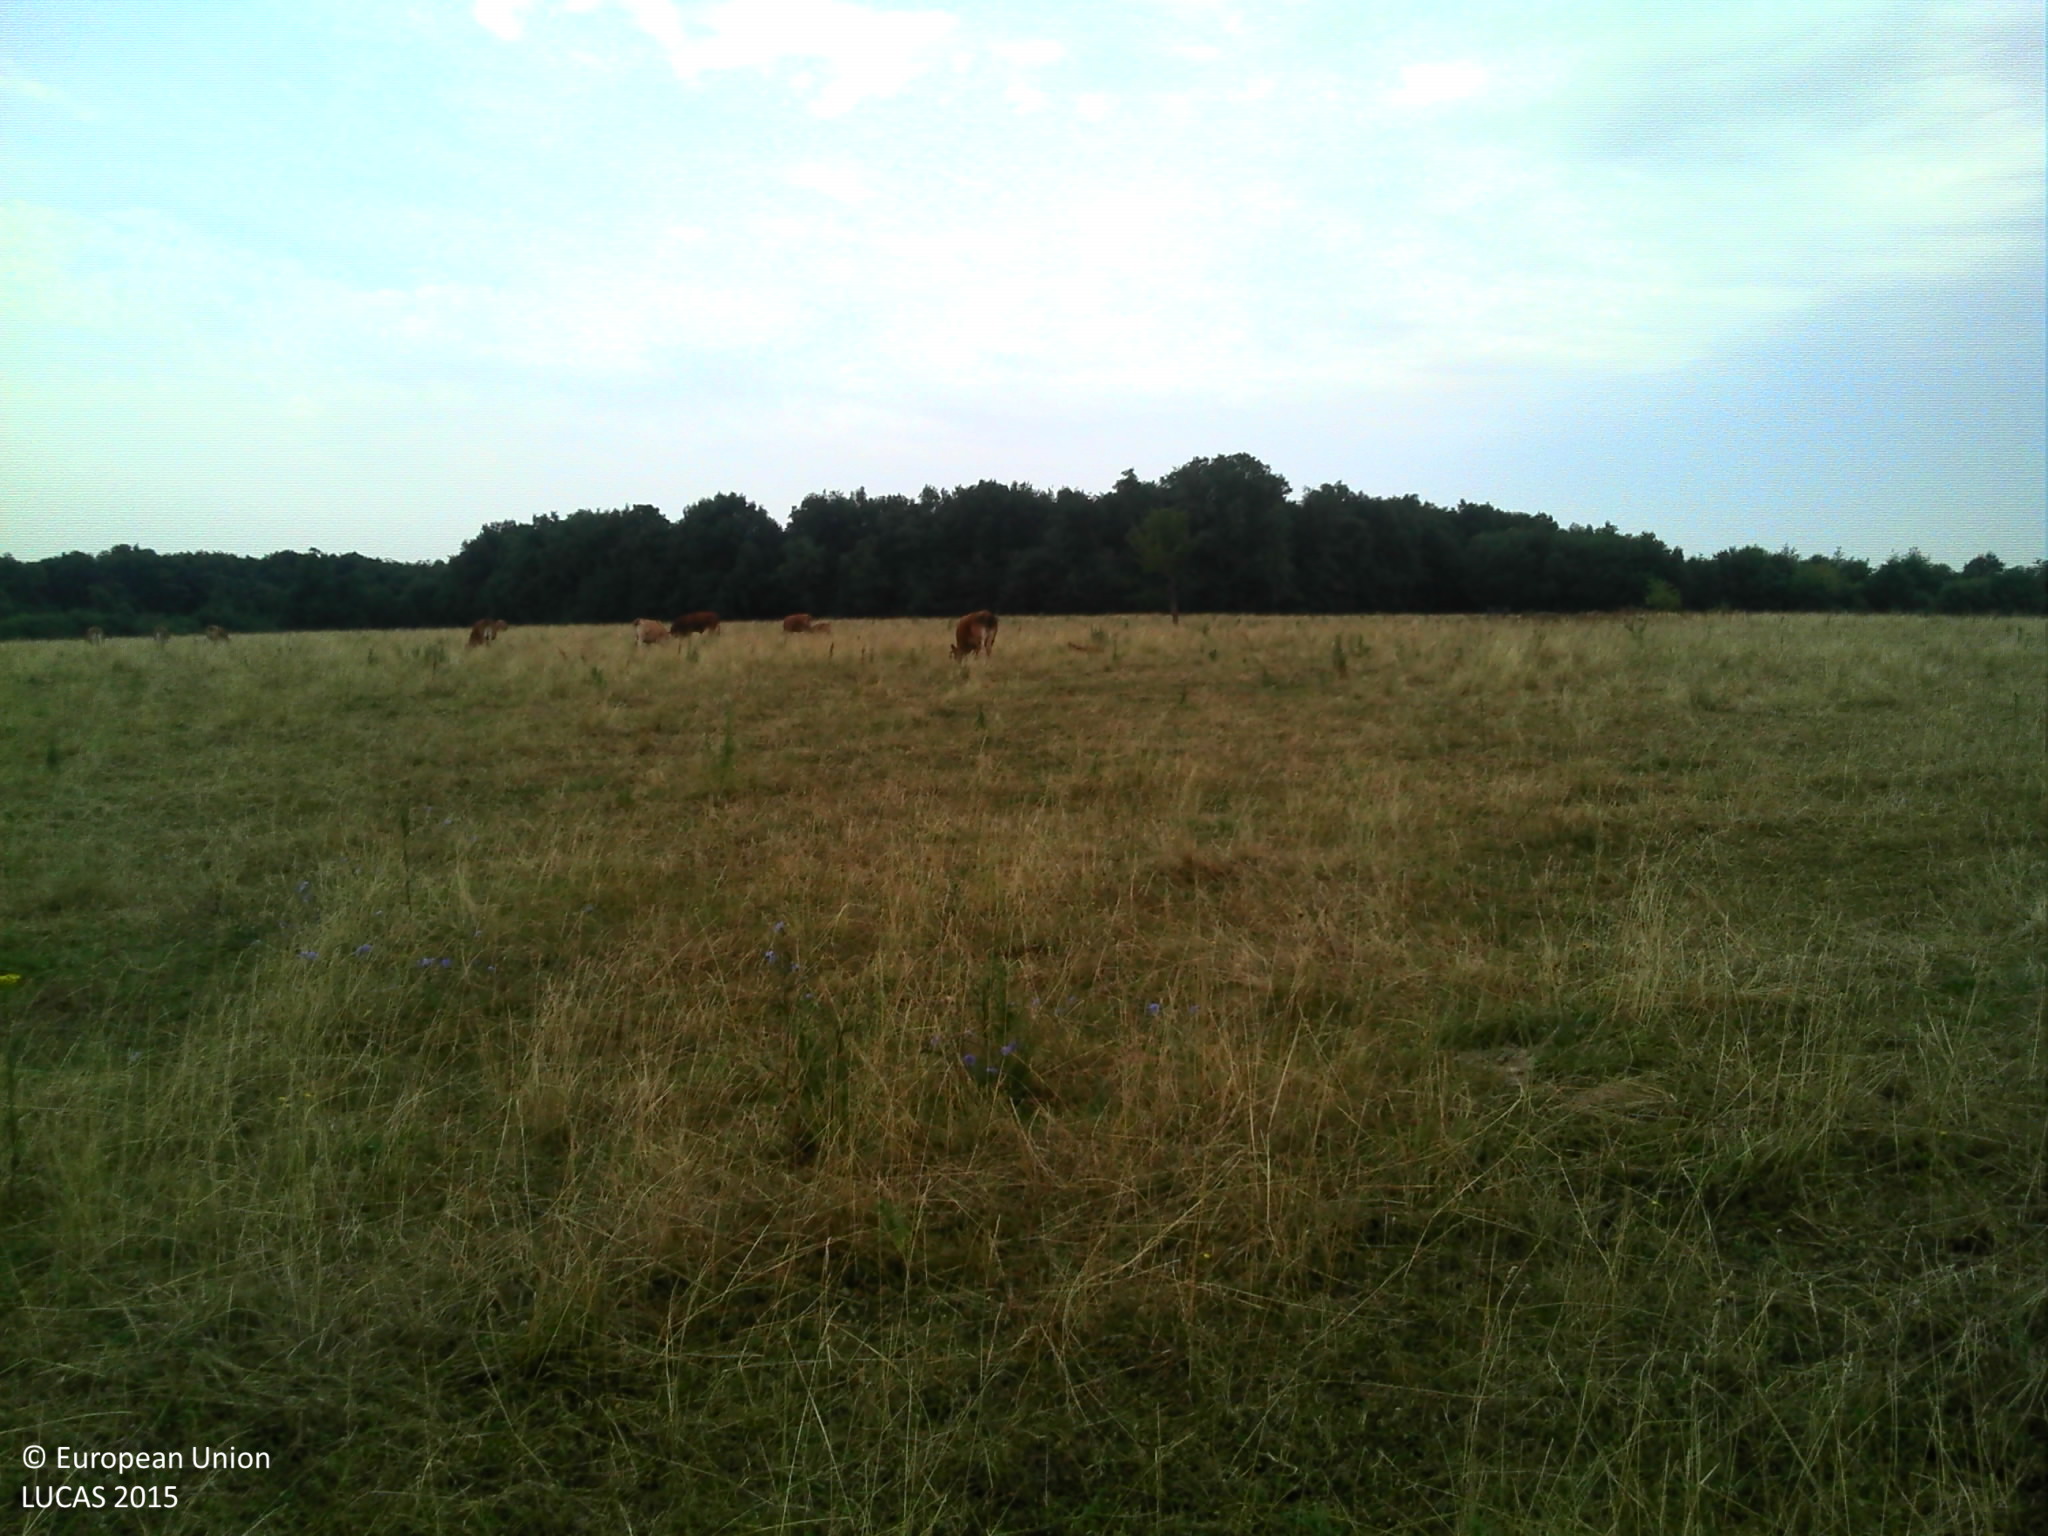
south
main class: Grassland
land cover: Grassland without tree/shrub cover
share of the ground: > 75 %
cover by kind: herbaceous plants 100 %
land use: Agriculture (excluding fallow land and kitchen gardens)
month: July
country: FR
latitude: 46.4283
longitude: 0.6274
